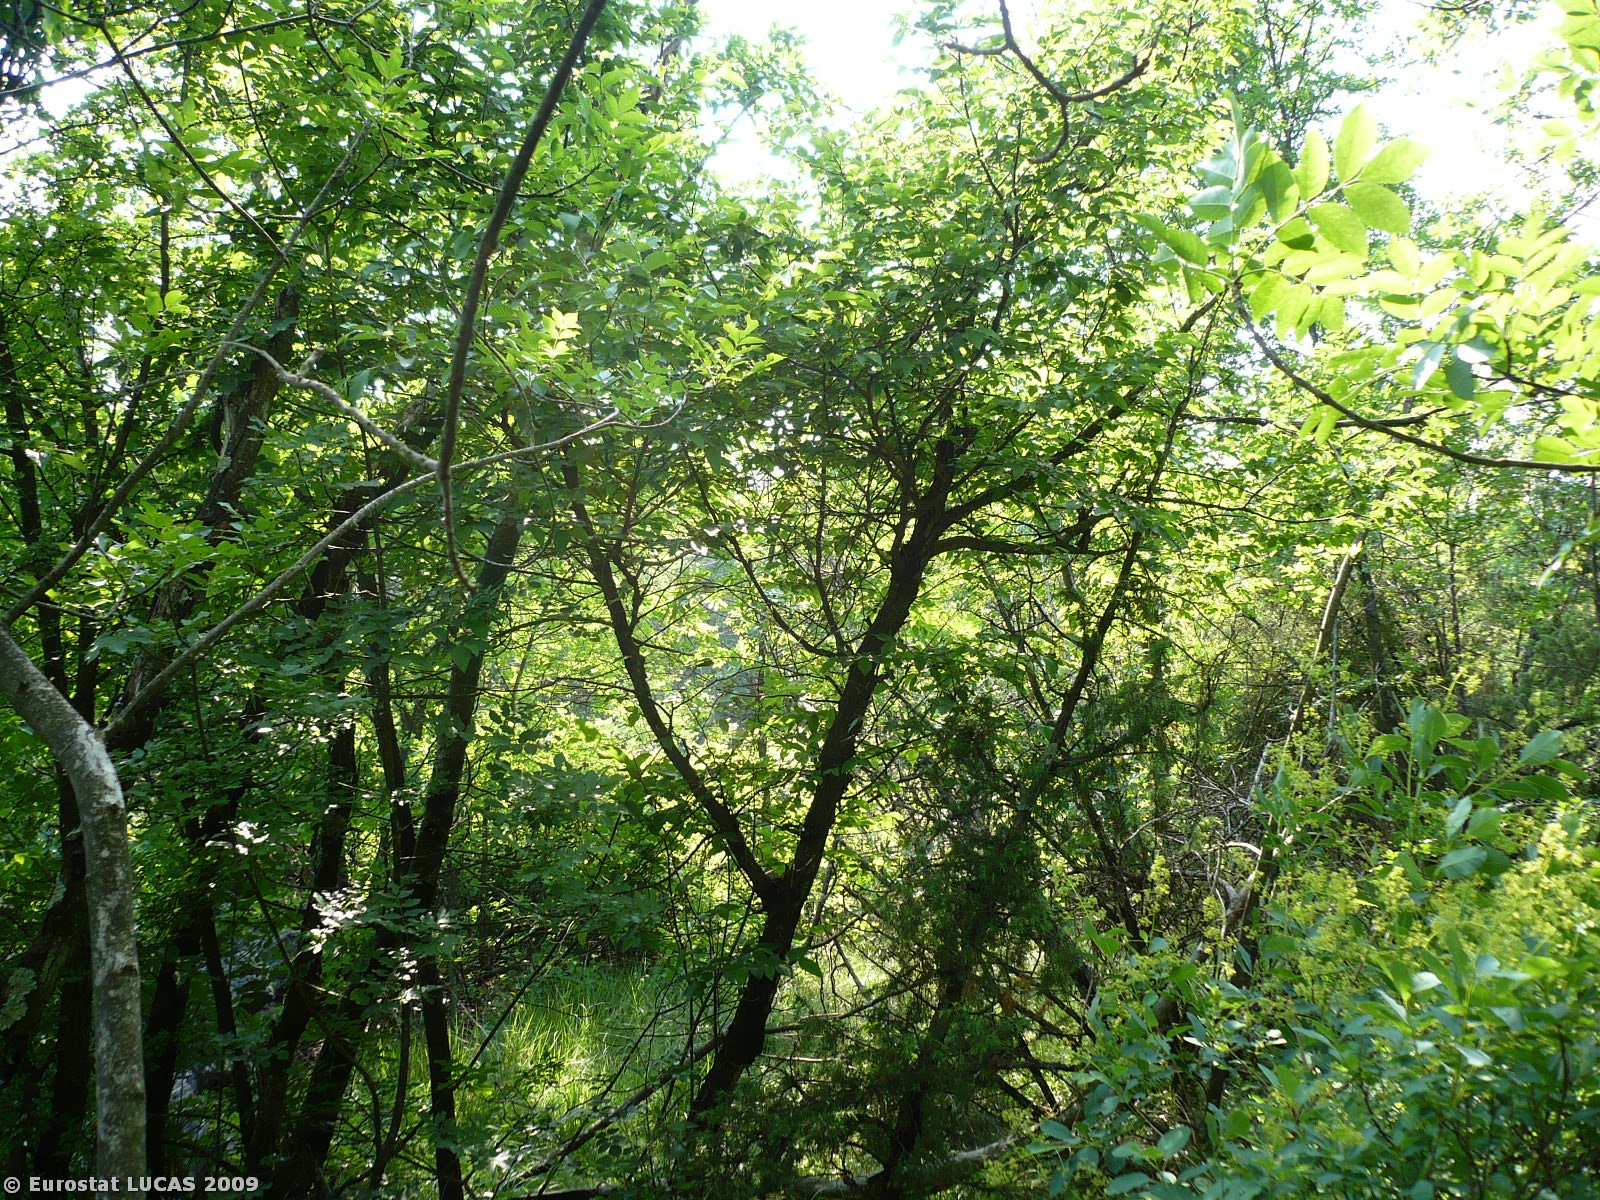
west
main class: Woodland
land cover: Broadleaved woodland
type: thermophilous deciduous forest
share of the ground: > 75 %
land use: Unused
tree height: > 5 m
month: May
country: SI
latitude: 45.8376
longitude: 13.6653
